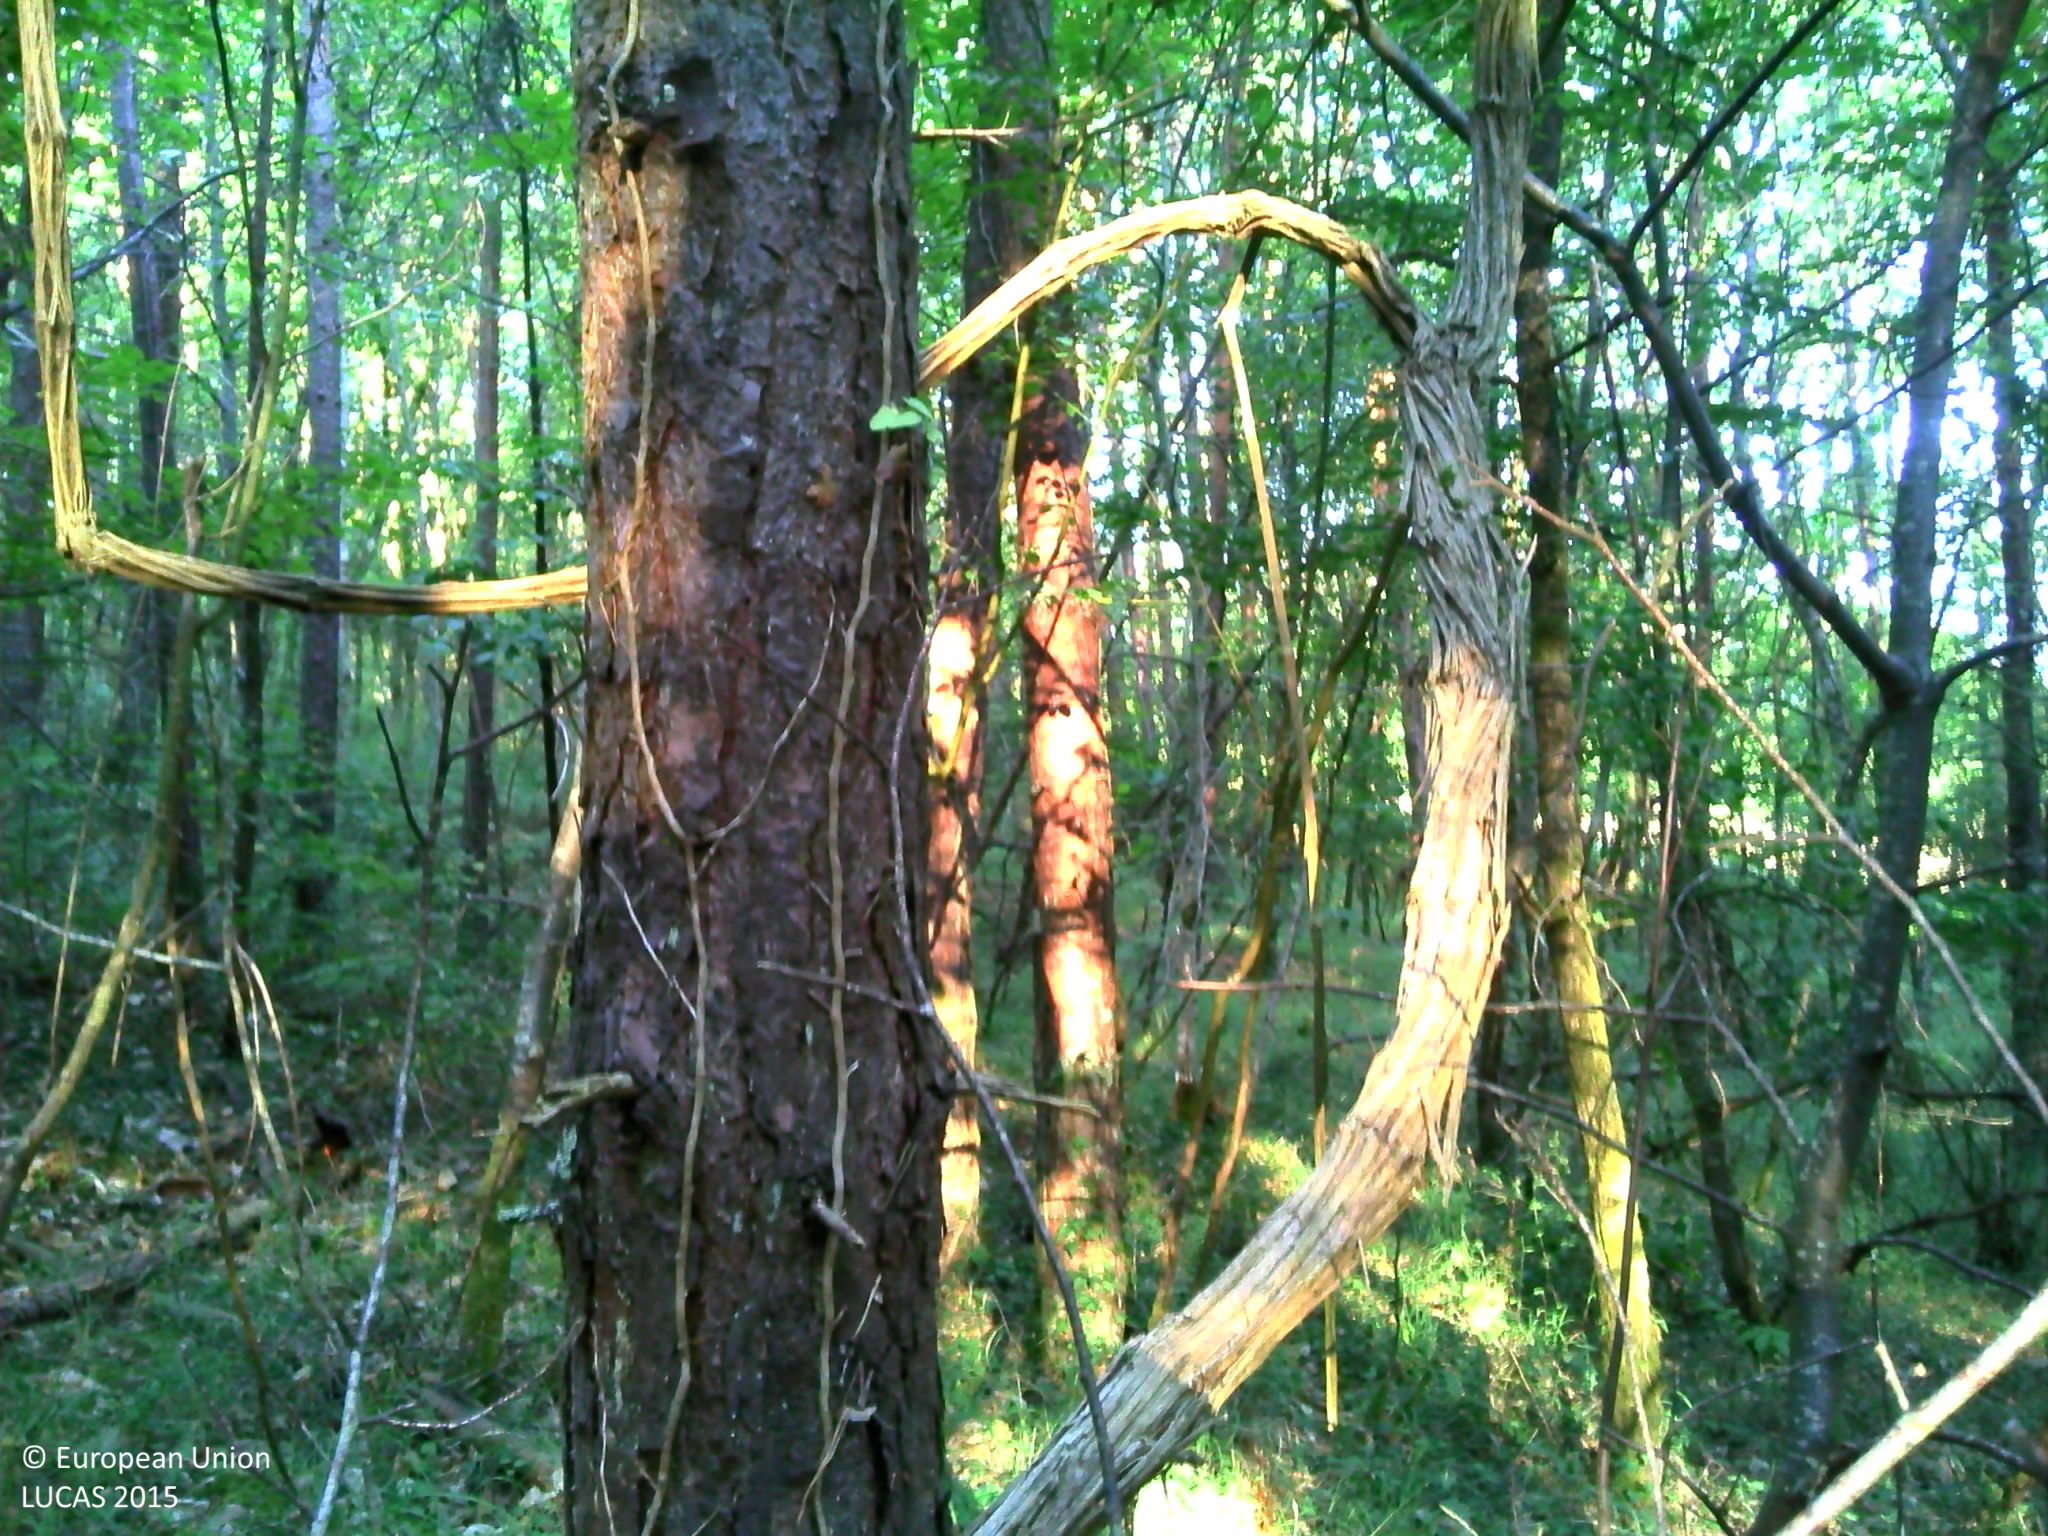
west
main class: Woodland
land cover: Pine dominated mixed woodland
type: mesophytic deciduous forest
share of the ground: > 75 %
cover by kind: broadleaved forest trees 60 %, coniferous forest trees 20 %, herbaceous plants 10 %, shrubs 5 %, lichens and mosses 5 %
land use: Forestry
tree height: > 5 m
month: August
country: FR
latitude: 44.8297
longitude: 0.7970
